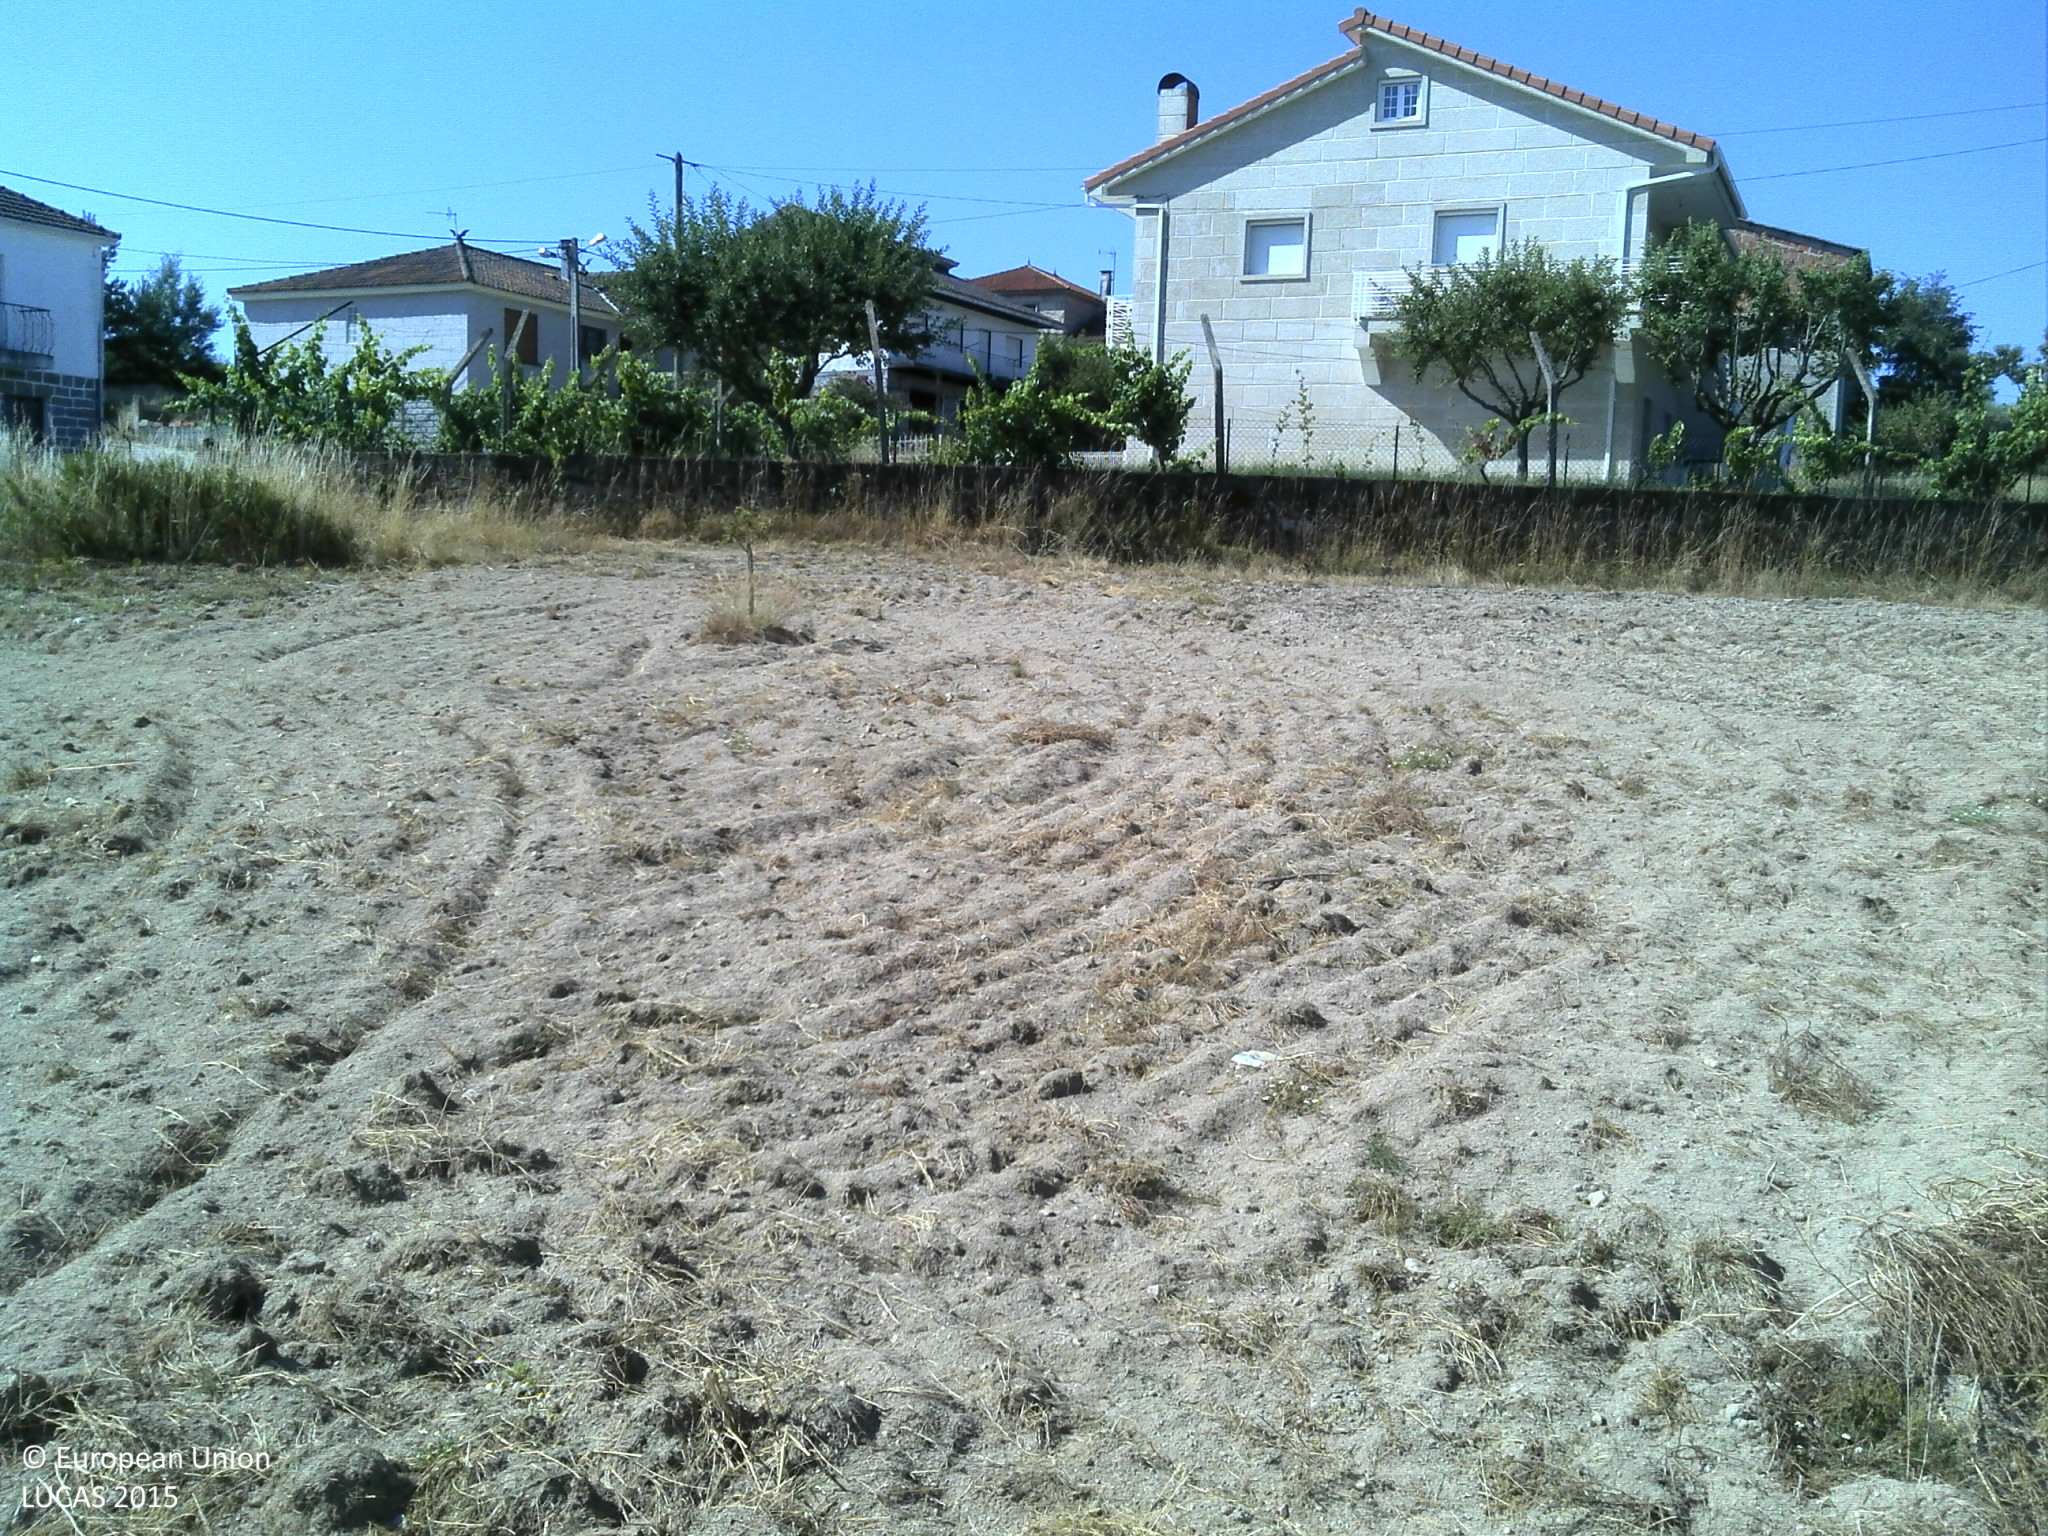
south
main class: Cropland
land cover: Other fruit trees and berries
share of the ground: 10 - 25 %
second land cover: Other bare soil
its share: > 75 %
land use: Agriculture (excluding fallow land and kitchen gardens)
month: July
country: PT
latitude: 41.8481
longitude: -7.6364
